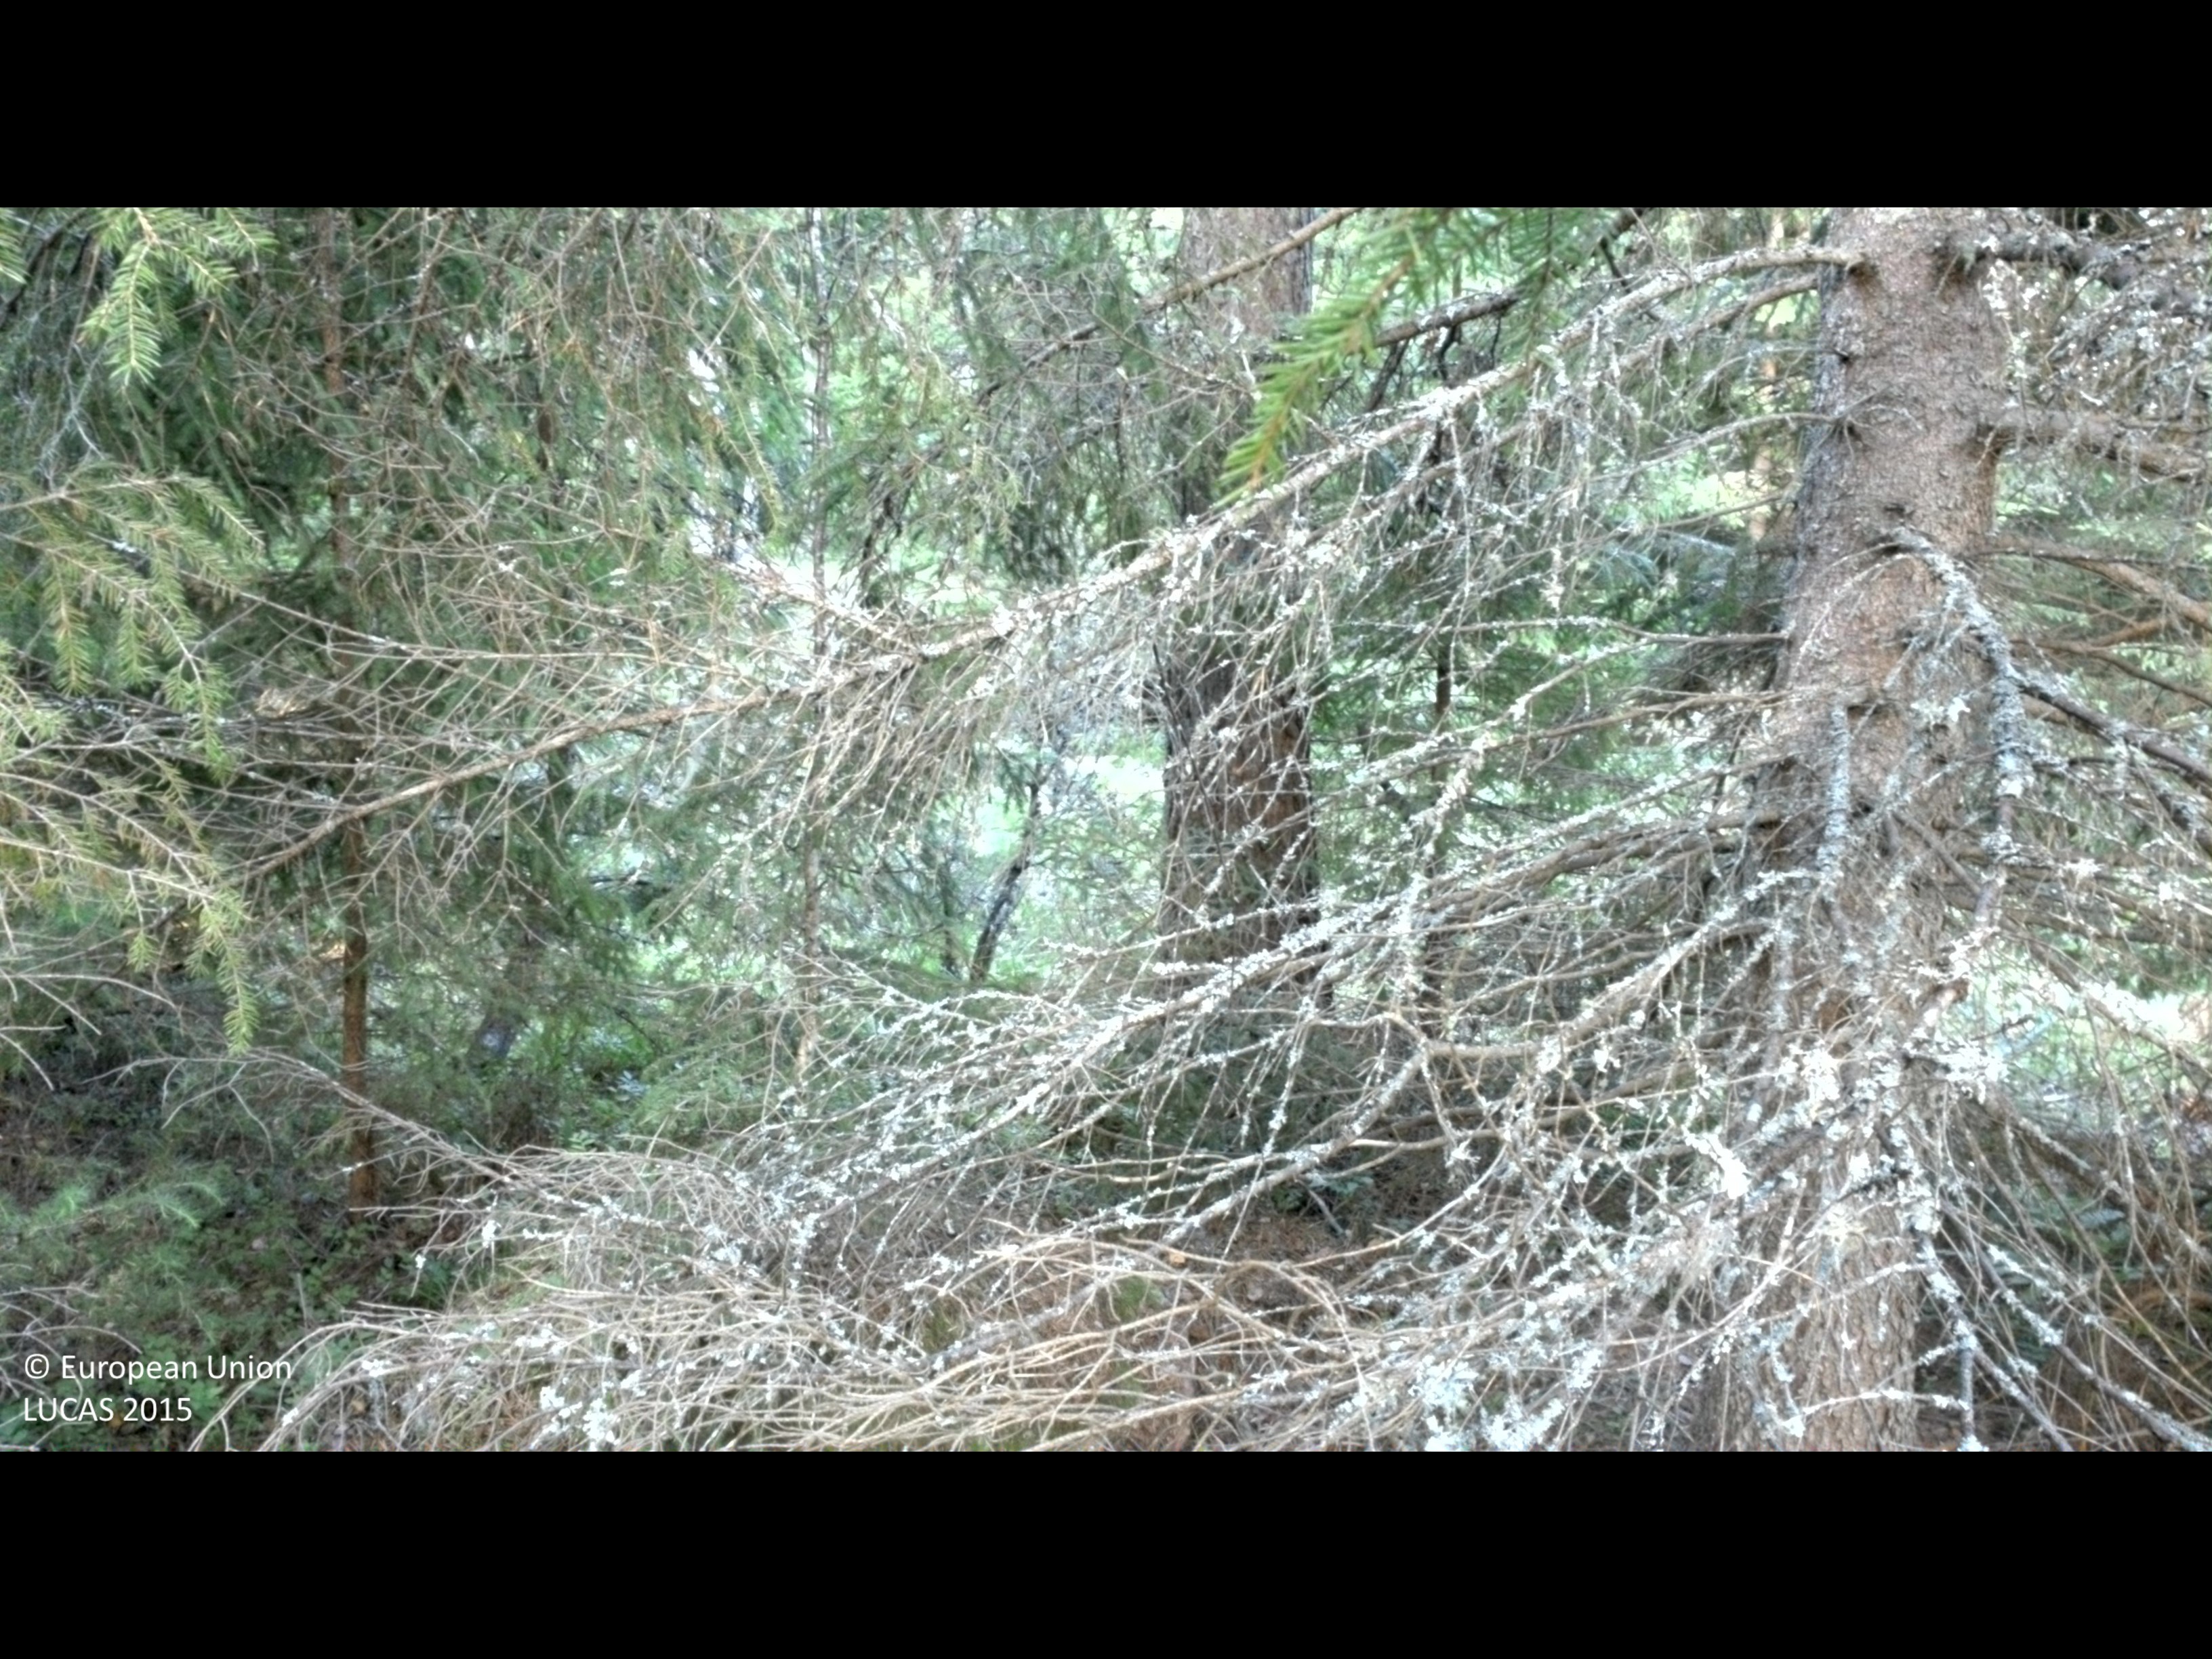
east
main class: Woodland
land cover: Spruce dominated coniferous woodland
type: boreal forest
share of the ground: 50 - 75 %
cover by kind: coniferous forest trees 55 %, shrubs 35 %, broadleaved forest trees 5 %, herbaceous plants 5 %
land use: Forestry
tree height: > 5 m
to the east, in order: Spruce dominated coniferous woodland; Tracks; Other coniferous woodland; Shrubland with sparse tree cover; Other coniferous woodland; Shrubland with sparse tree cover; Spruce dominated coniferous woodland; Pine dominated coniferous woodland
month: July
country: SE
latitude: 58.0740
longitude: 16.2529
